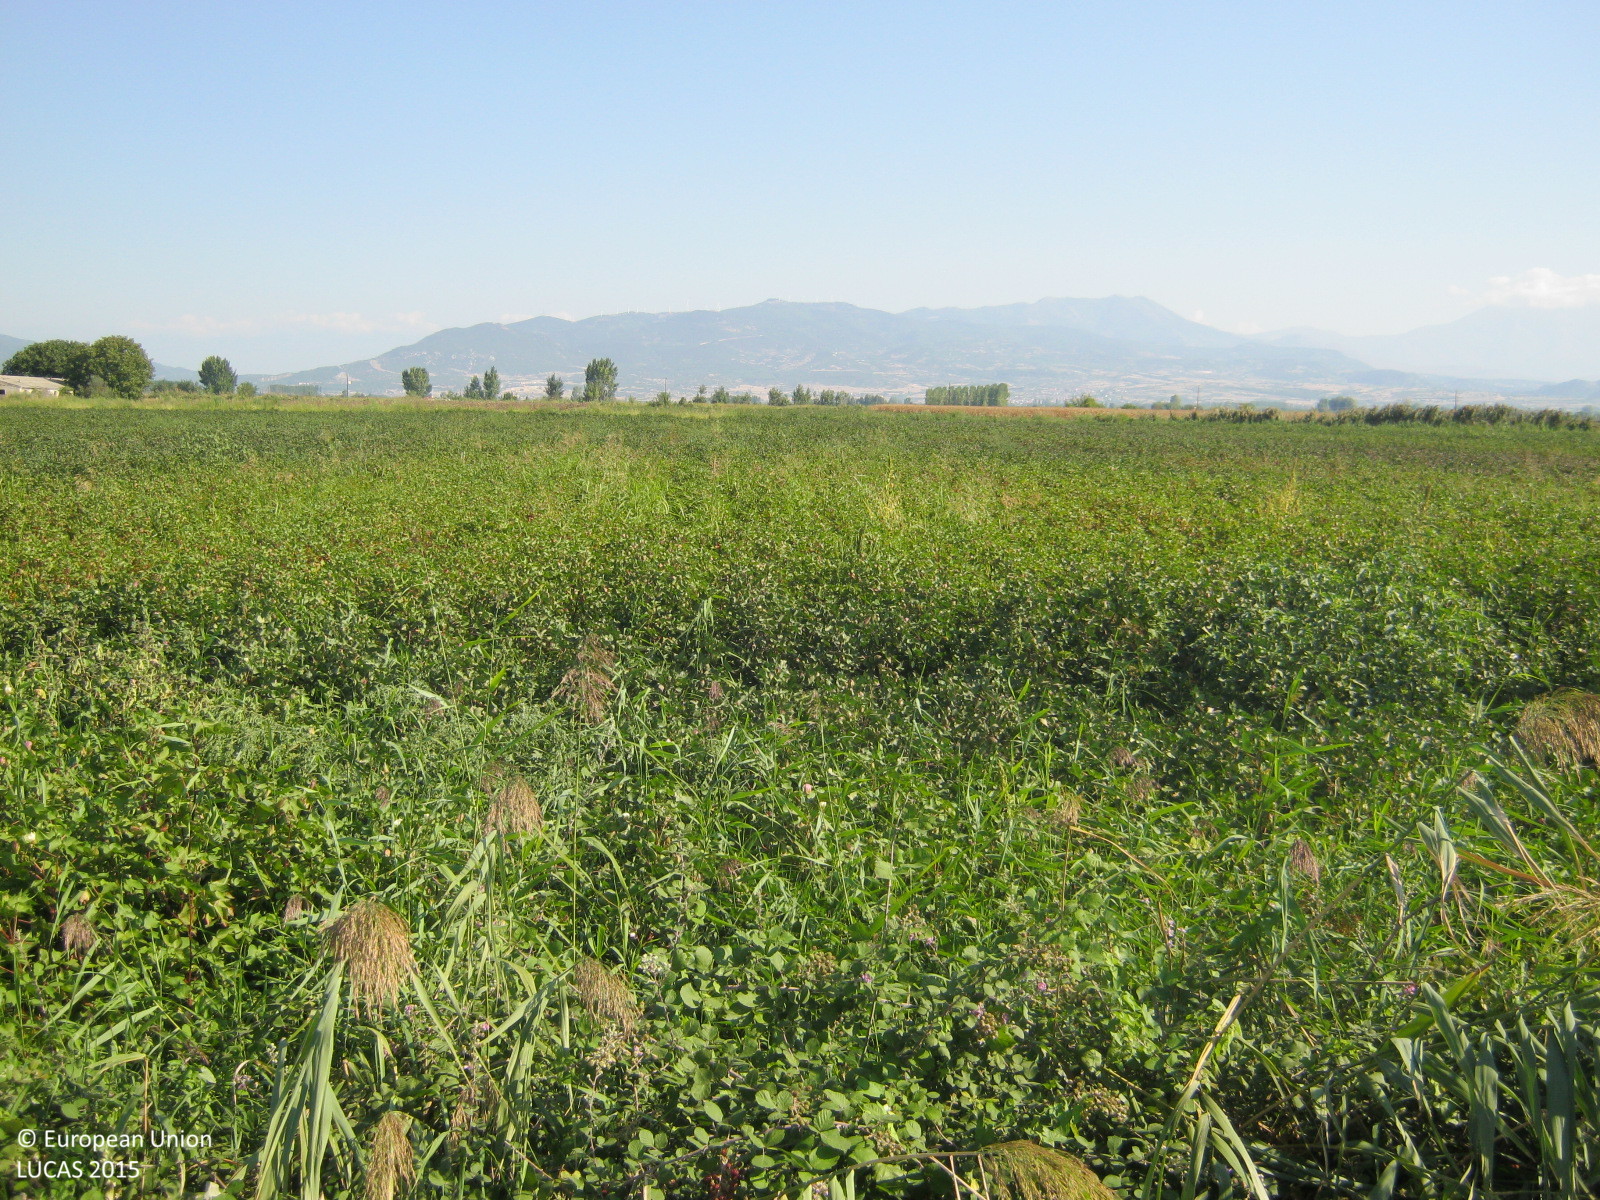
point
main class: Cropland
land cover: Cotton
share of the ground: > 75 %
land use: Agriculture (excluding fallow land and kitchen gardens)
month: September
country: GR
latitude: 41.2037
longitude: 23.3150
